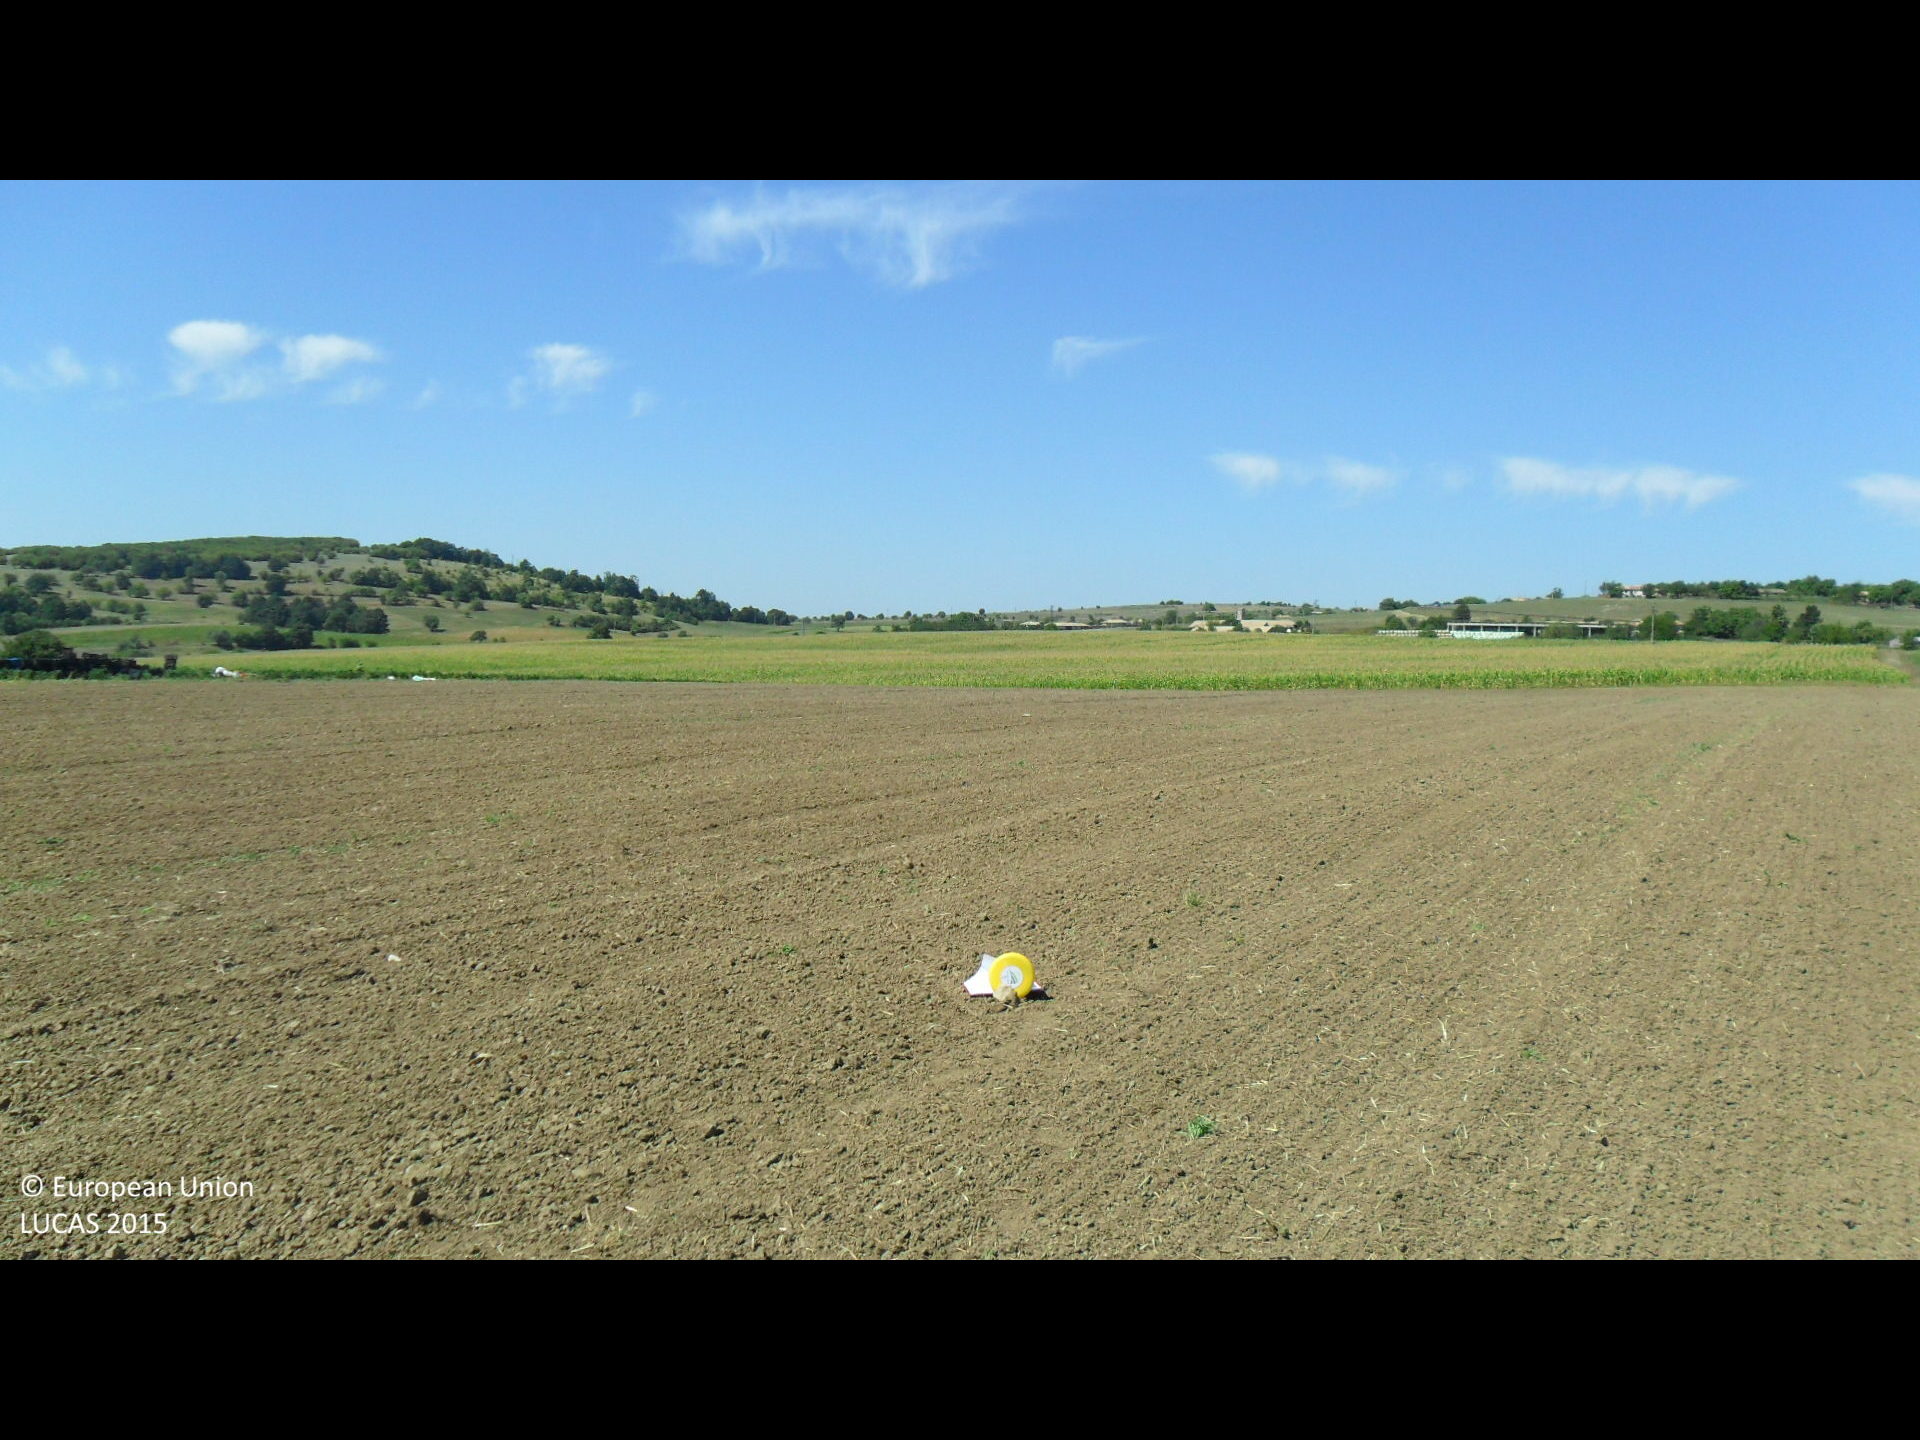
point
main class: Cropland
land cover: Common wheat
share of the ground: < 10 %
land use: Agriculture (excluding fallow land and kitchen gardens)
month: September
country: BG
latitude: 43.1741
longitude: 26.4482
